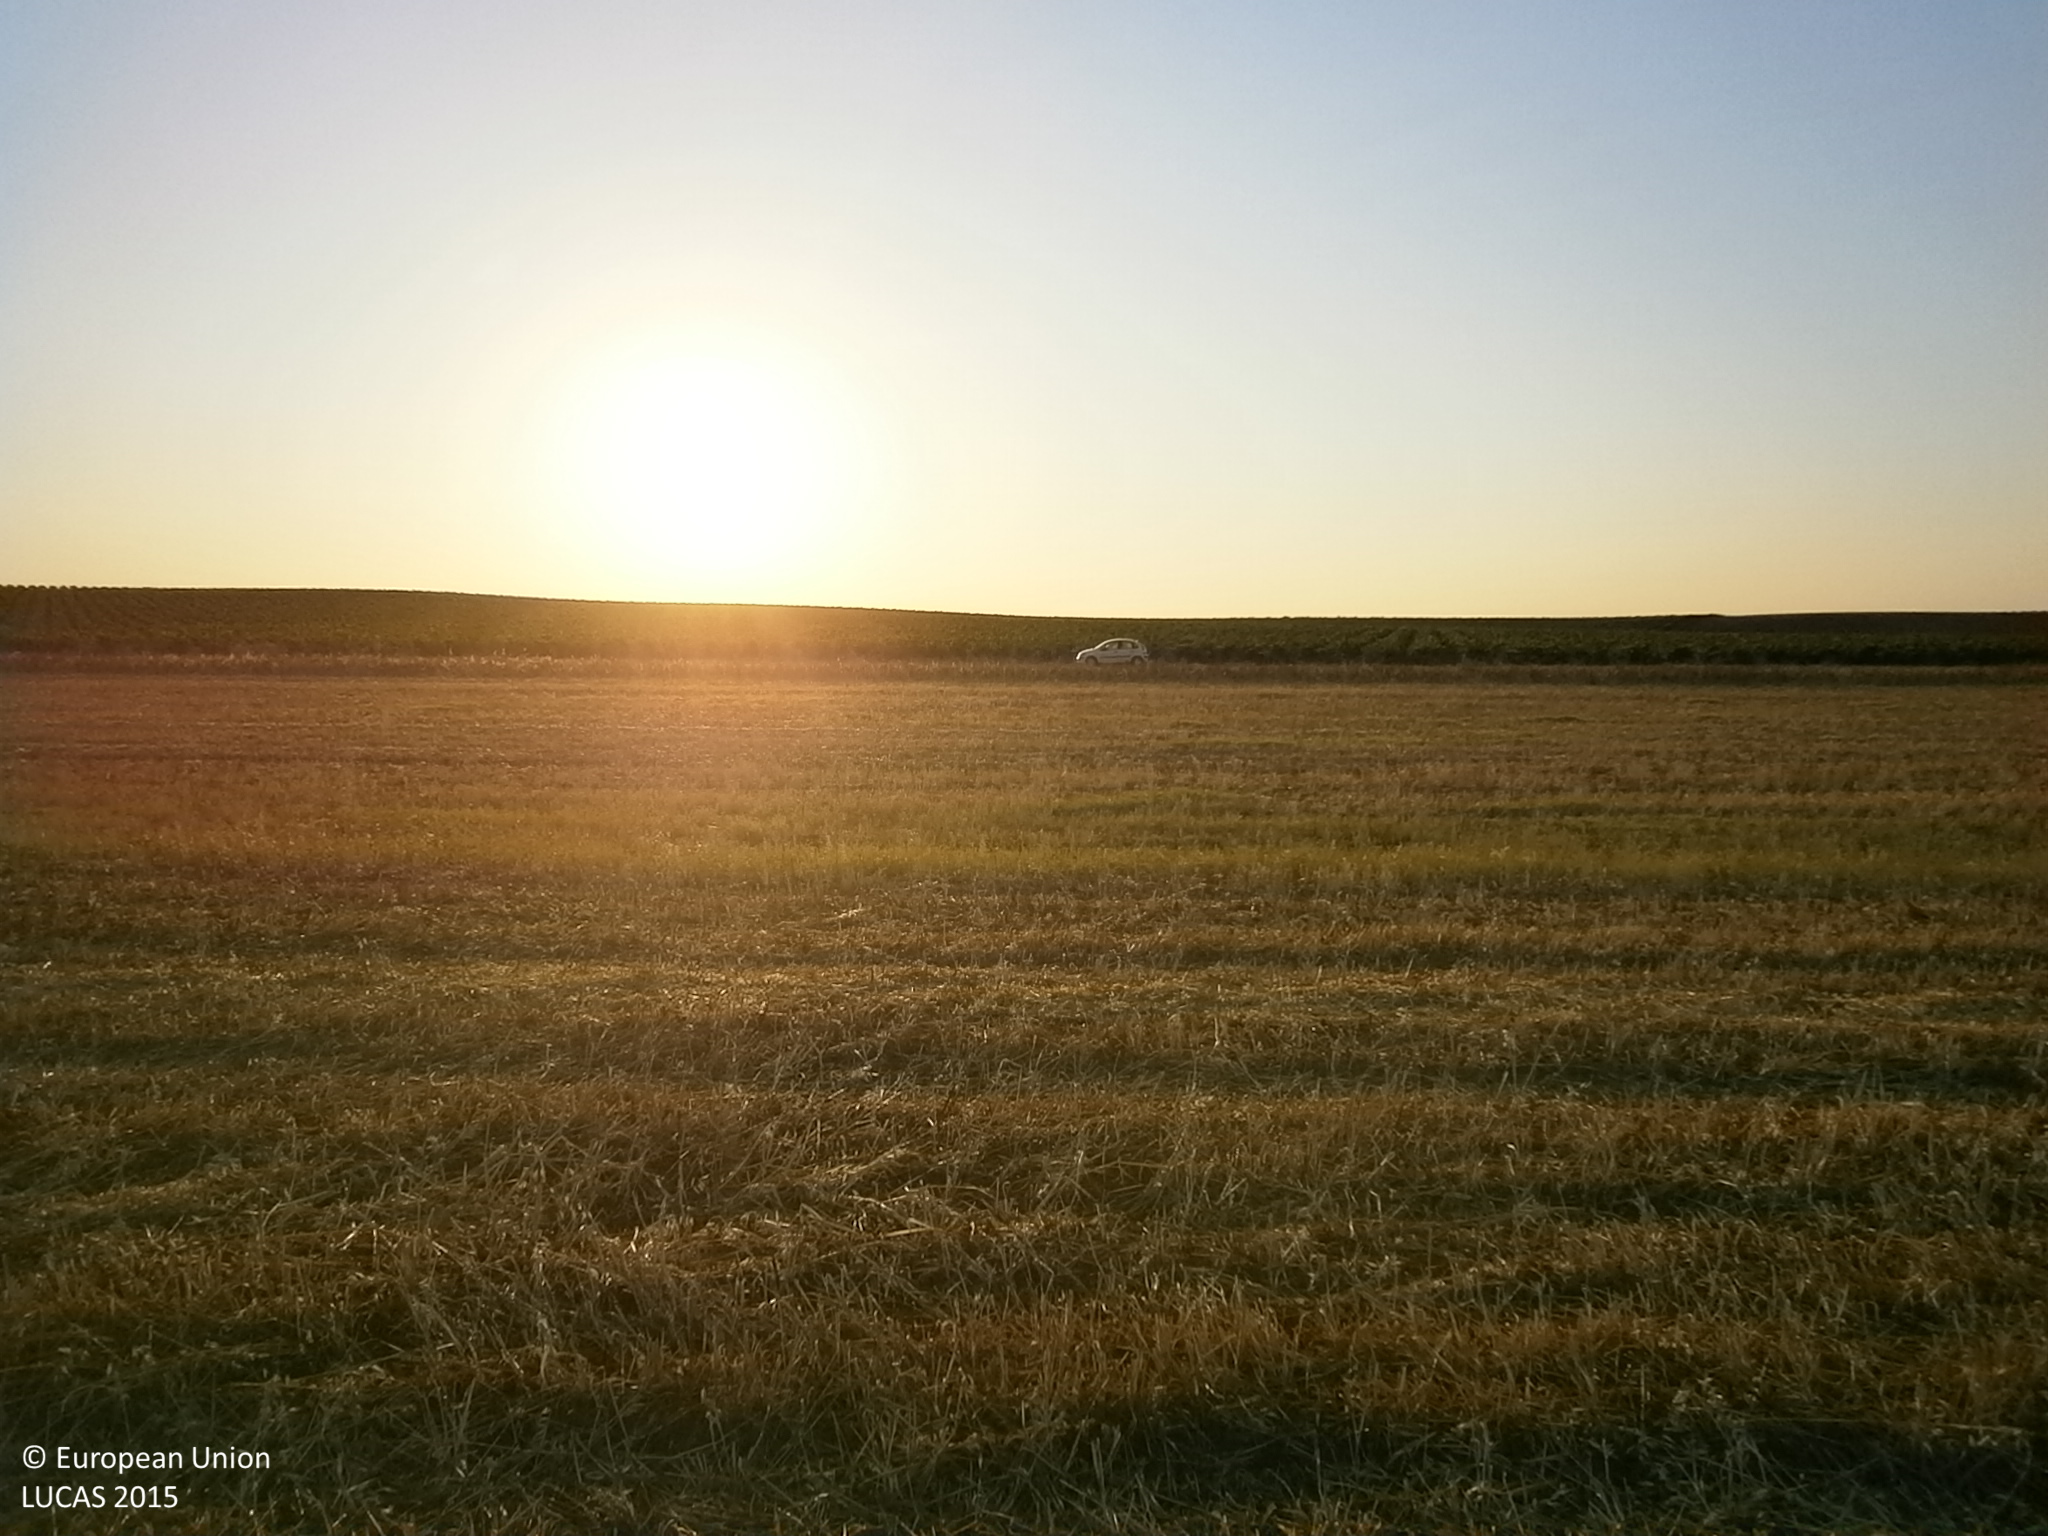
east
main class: Cropland
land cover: Oats
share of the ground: > 75 %
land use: Agriculture (excluding fallow land and kitchen gardens)
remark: Harvested field
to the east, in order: Oats; Vineyards
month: June
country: ES
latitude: 38.7232
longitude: -6.7518
